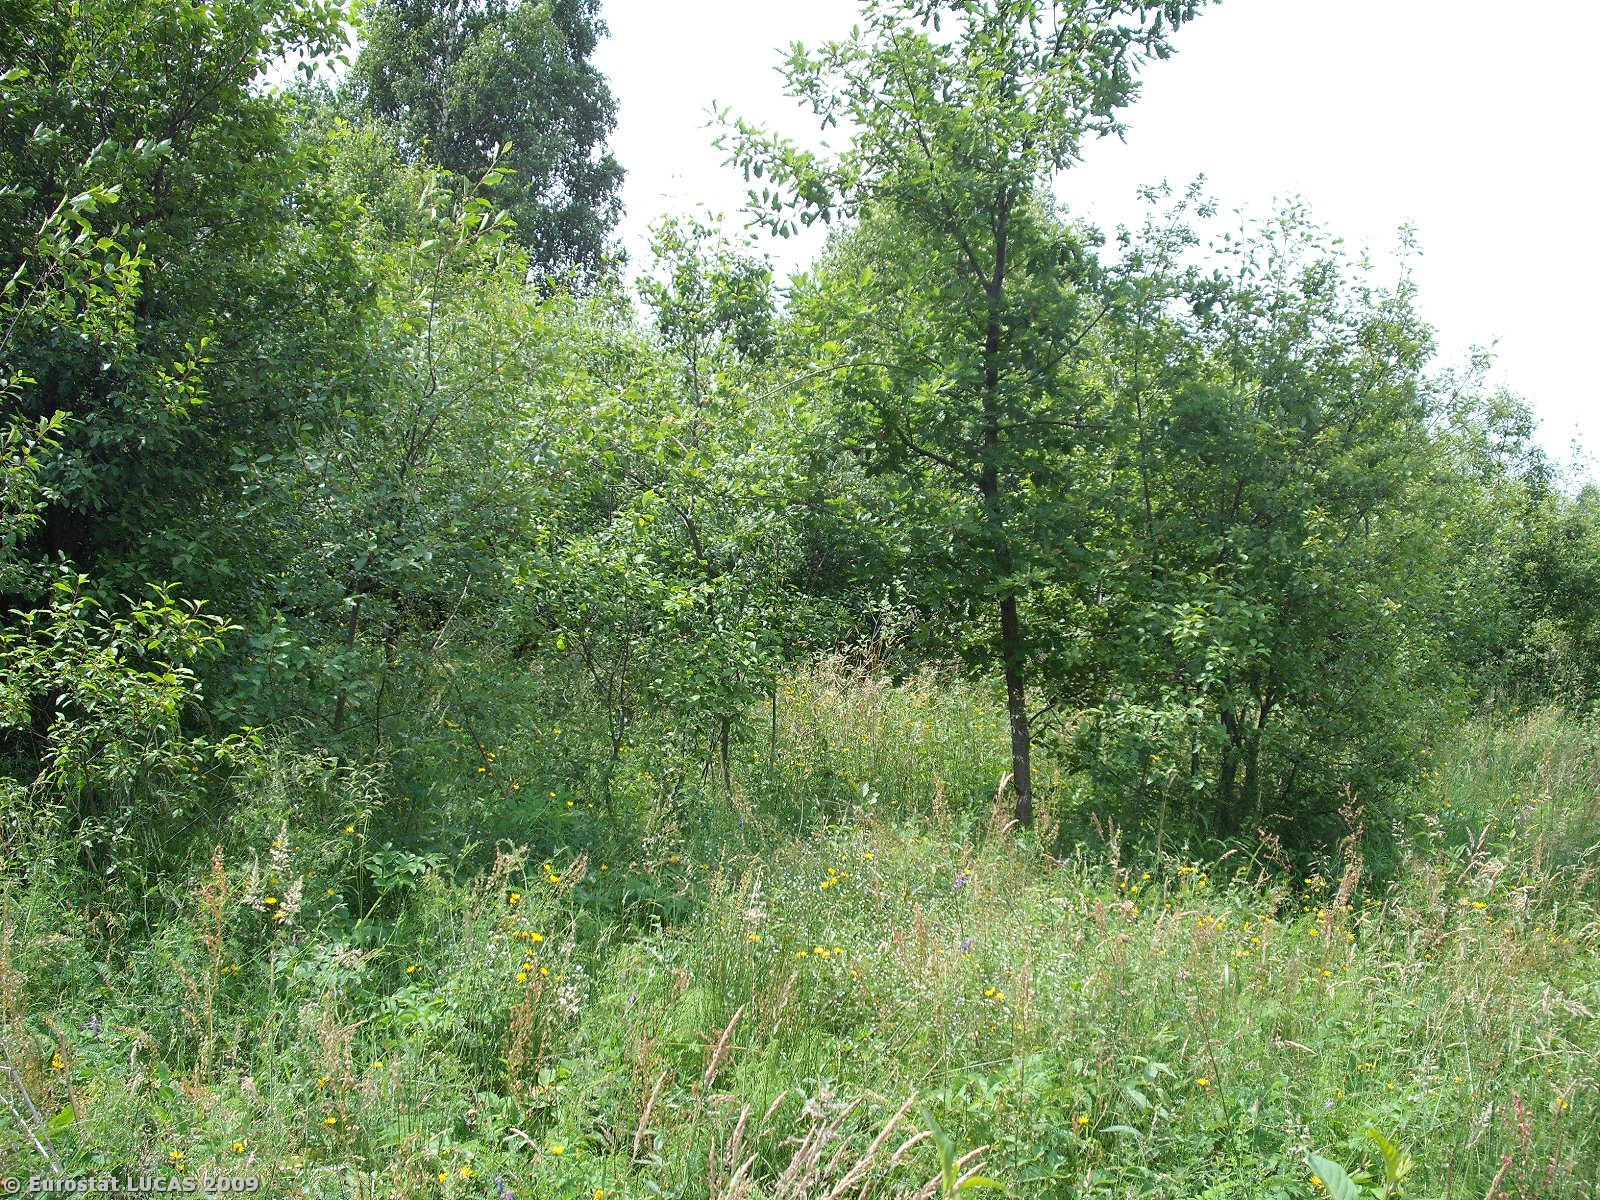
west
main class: Woodland
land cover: Broadleaved woodland
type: mesophytic deciduous forest
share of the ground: 25 - 50 %
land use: Unused
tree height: > 5 m
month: June
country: PL
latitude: 51.2513
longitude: 20.5699
